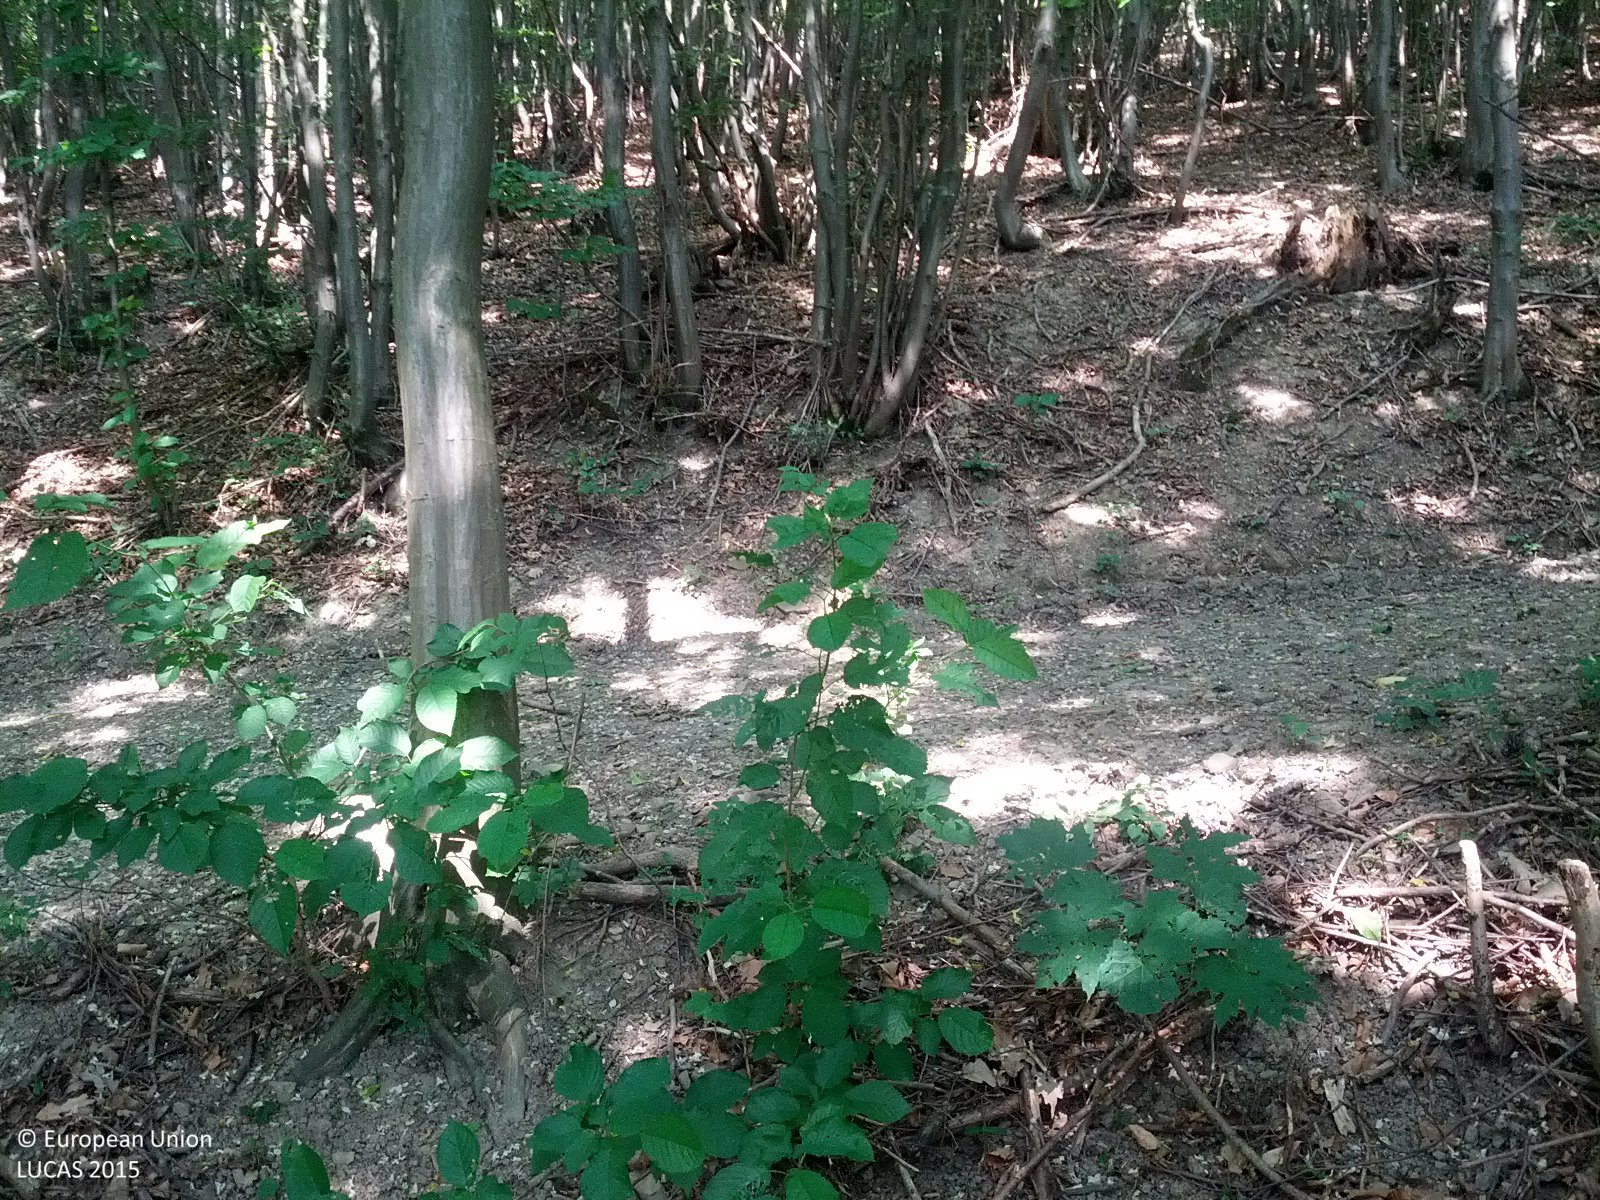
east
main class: Woodland
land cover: Broadleaved woodland
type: beech forest
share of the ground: > 75 %
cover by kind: broadleaved forest trees 100 %
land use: Forestry
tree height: > 5 m
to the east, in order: Broadleaved woodland; Fences; Broadleaved woodland; Tracks; Broadleaved woodland
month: June
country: AT
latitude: 48.1617
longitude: 16.1213
